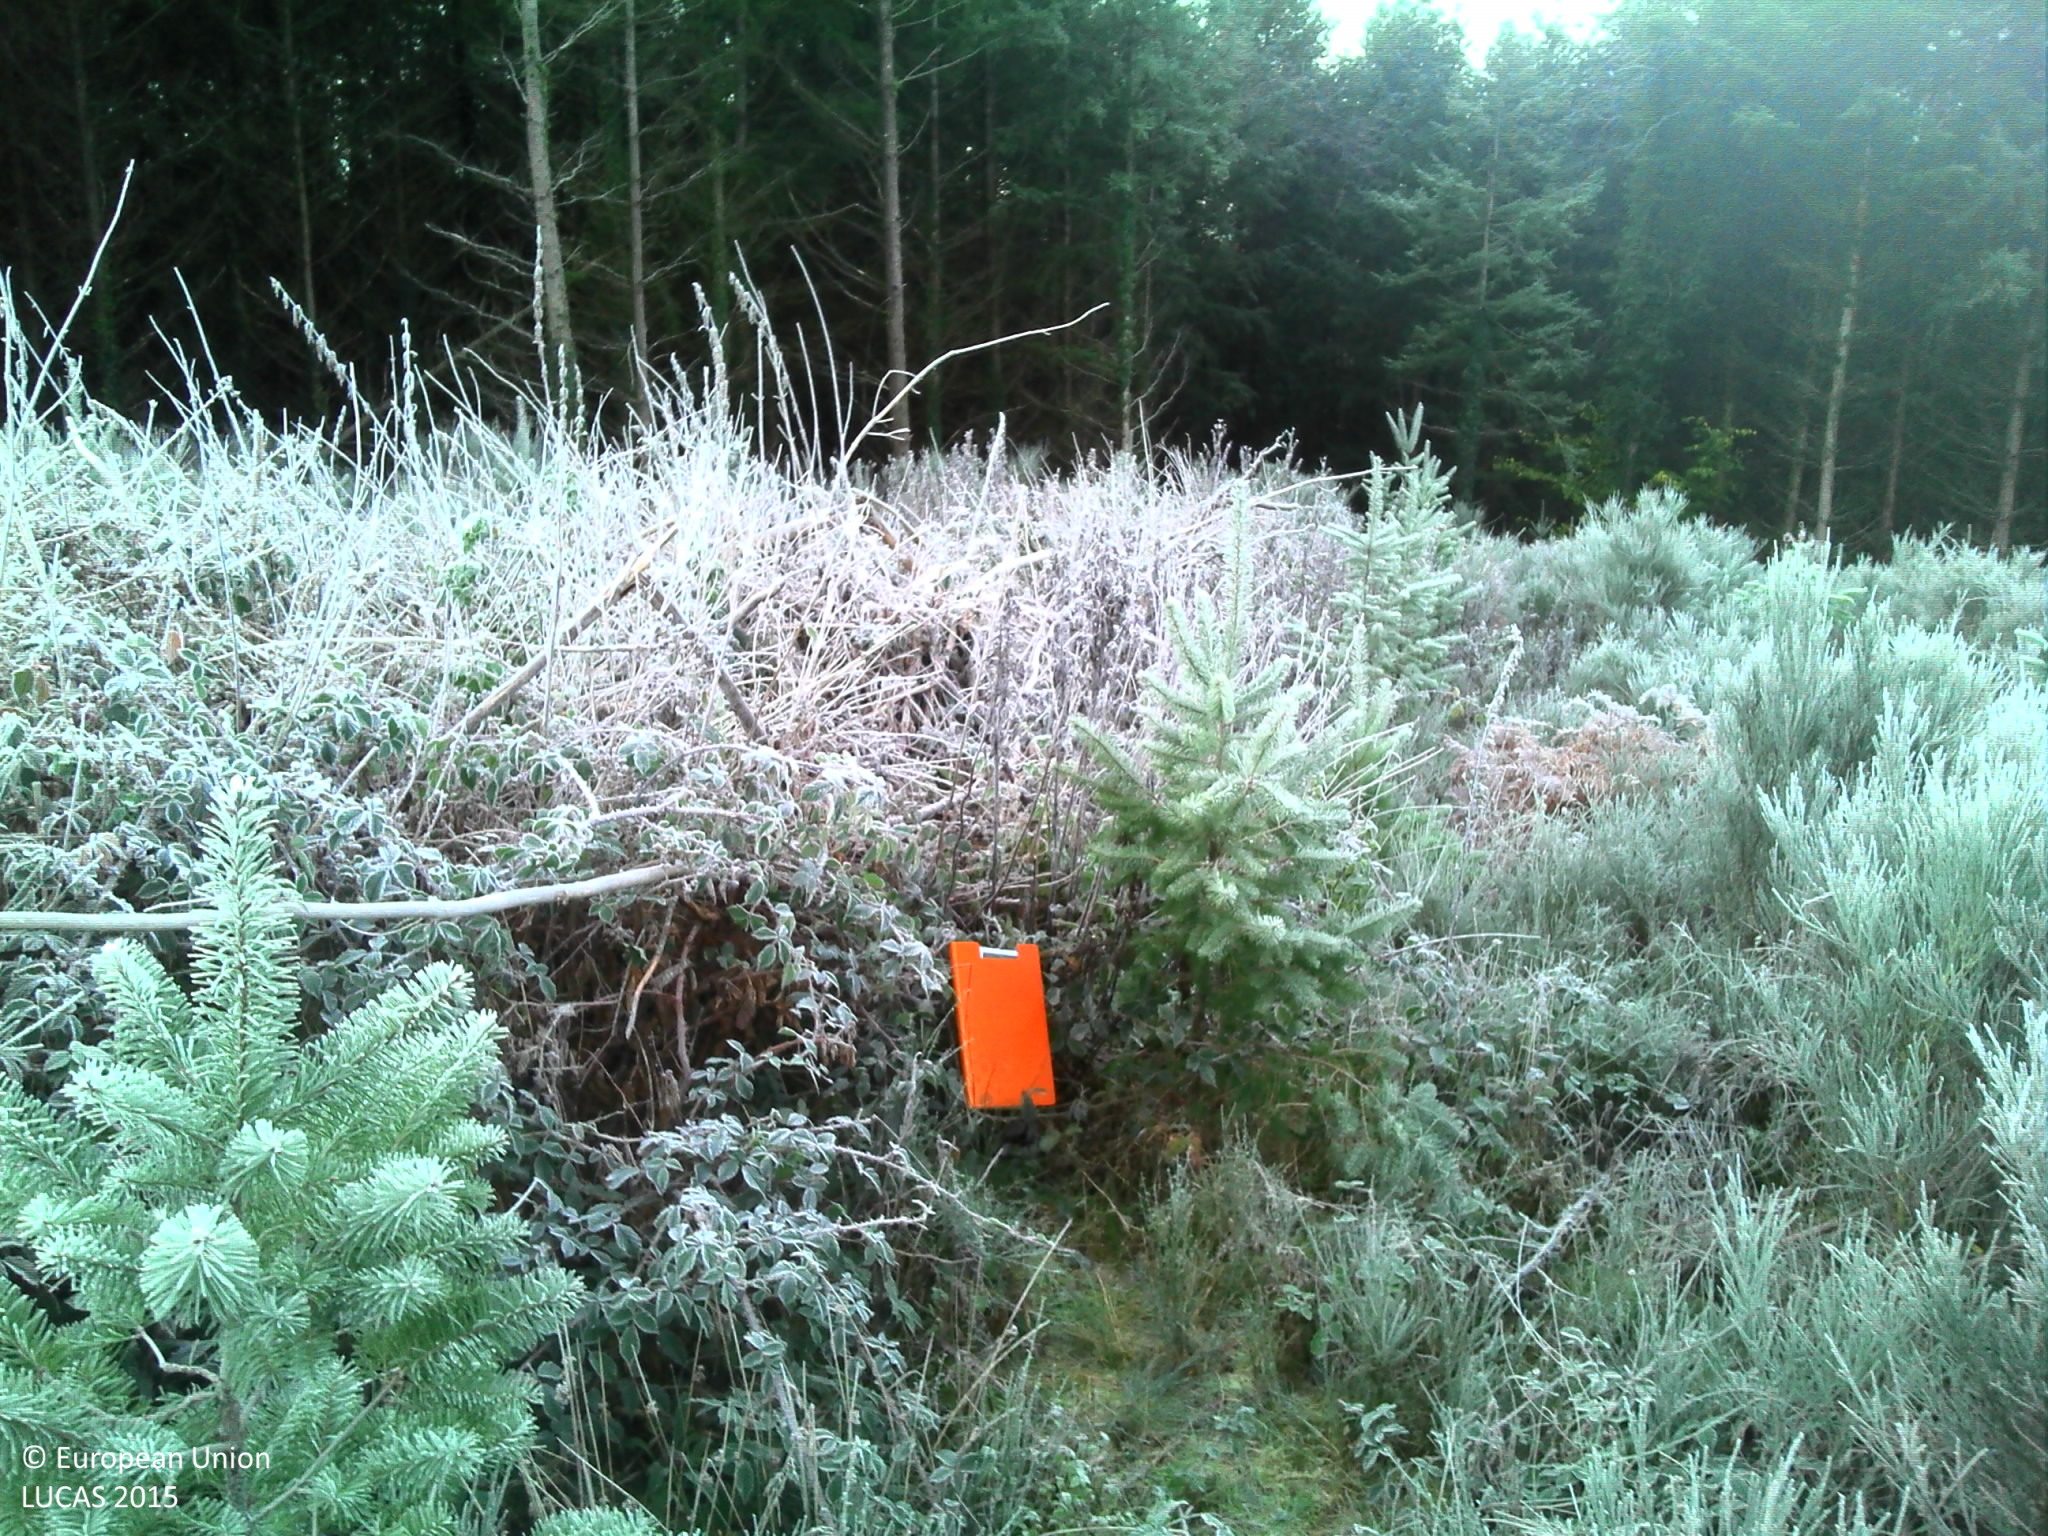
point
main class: Shrubland
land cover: Shrubland with sparse tree cover
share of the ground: > 75 %
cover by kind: shrubs 80 %, herbaceous plants 15 %, coniferous forest trees 5 %
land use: Forestry
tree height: < 5 m
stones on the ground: < 10 %
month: November
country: FR
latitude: 46.1830
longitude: 3.6911
